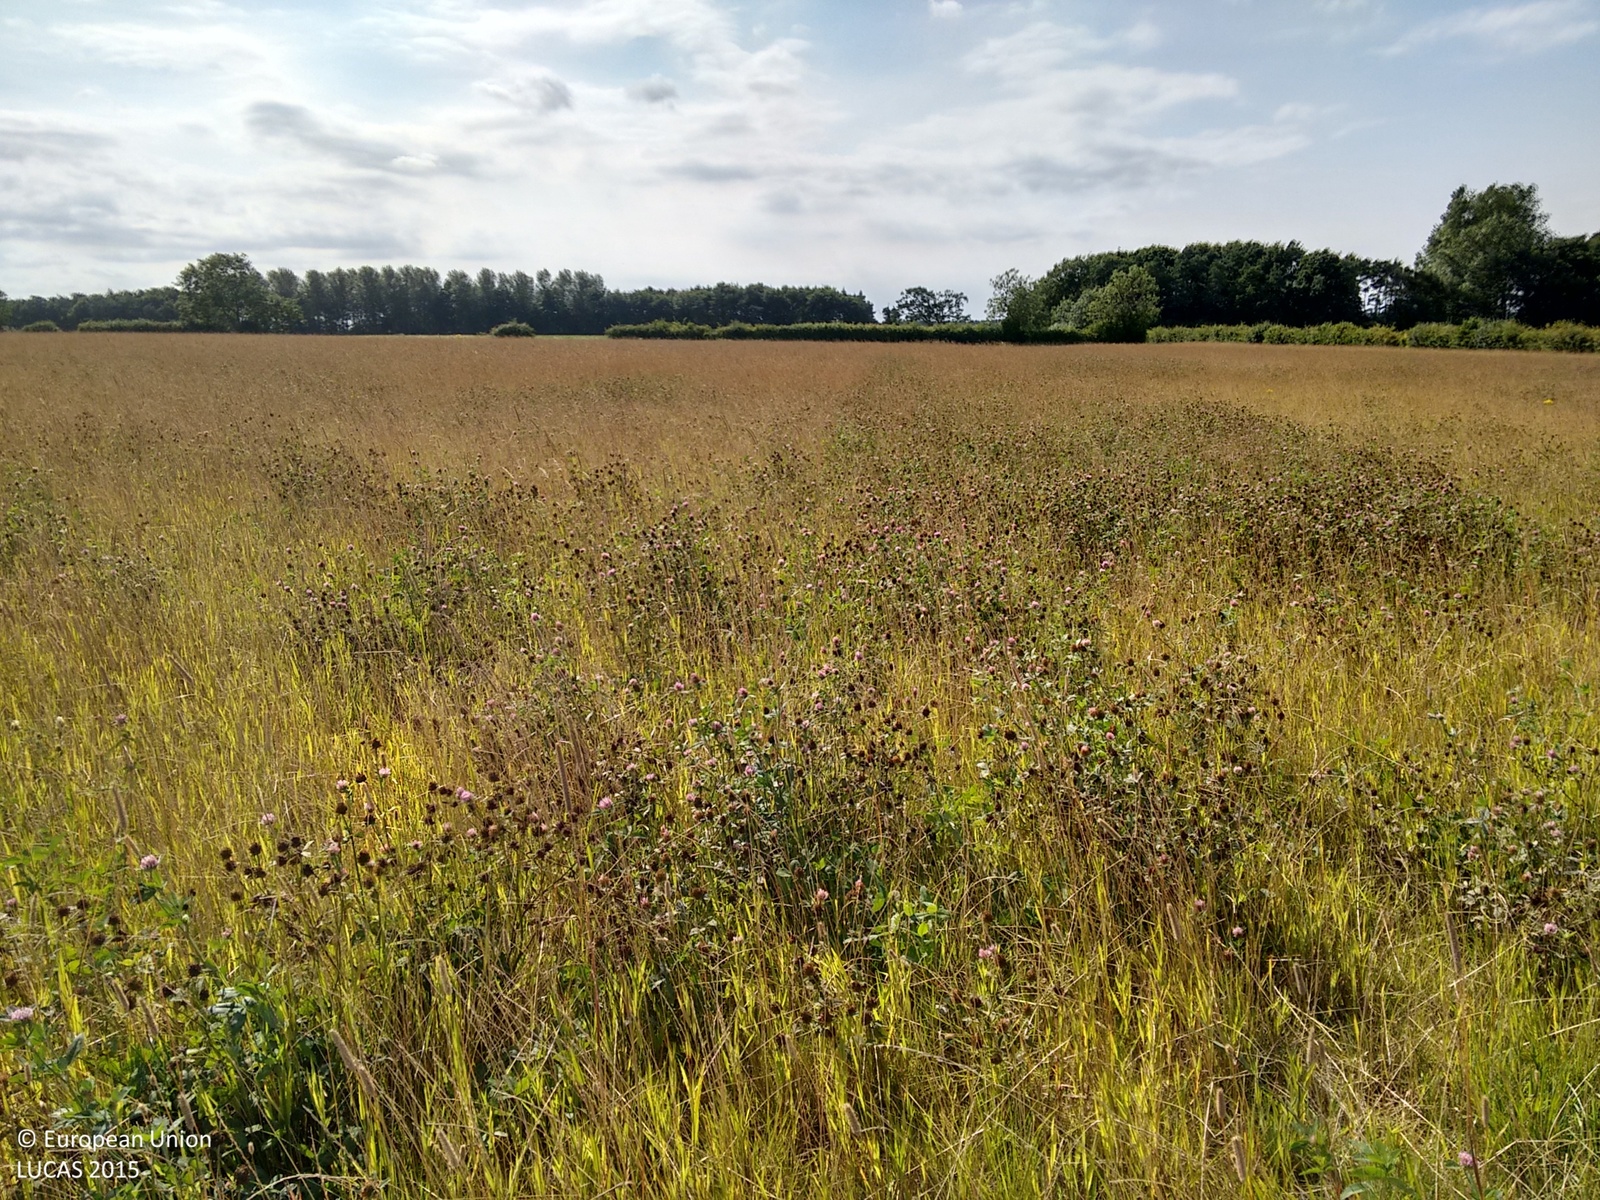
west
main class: Grassland
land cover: Grassland without tree/shrub cover
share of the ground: > 75 %
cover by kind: herbaceous plants 100 %
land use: Agriculture (excluding fallow land and kitchen gardens)
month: August
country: GB
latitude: 52.7417
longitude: 0.7768
